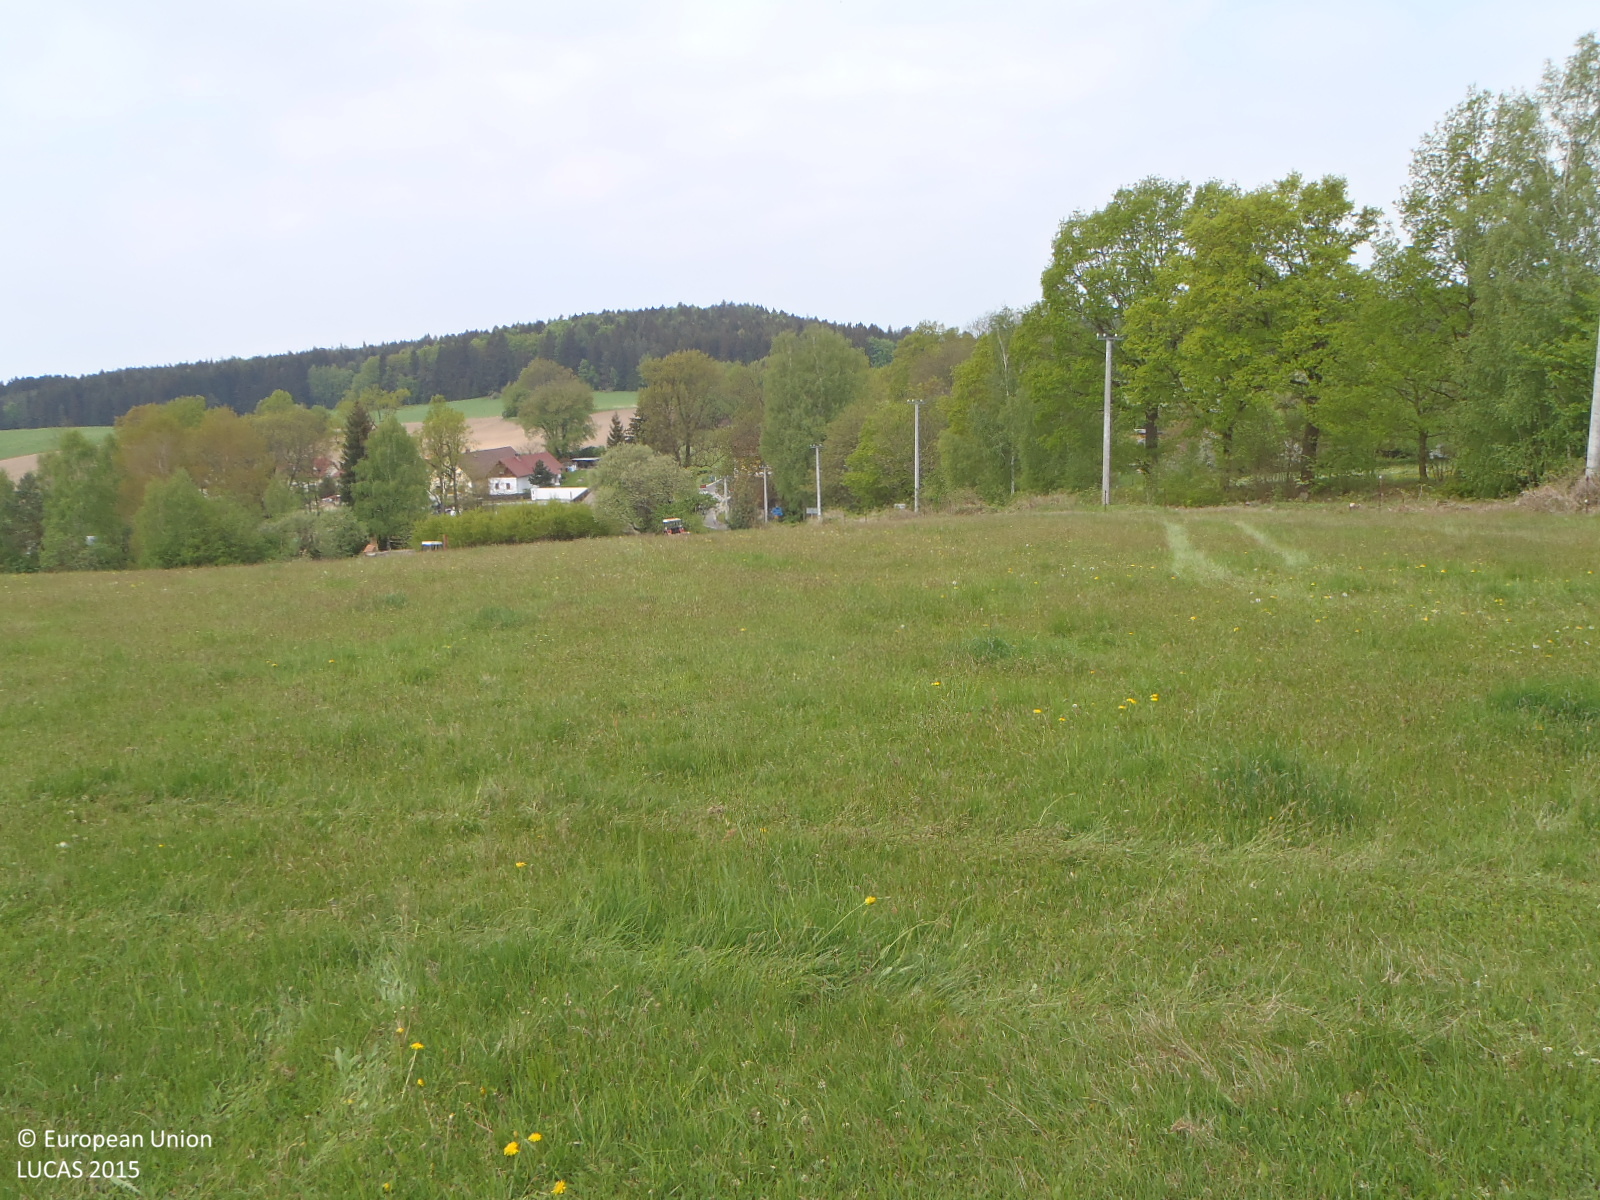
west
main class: Grassland
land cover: Grassland without tree/shrub cover
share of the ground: > 75 %
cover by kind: herbaceous plants 100 %
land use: Agriculture (excluding fallow land and kitchen gardens)
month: May
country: CZ
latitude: 49.0607
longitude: 15.1071
